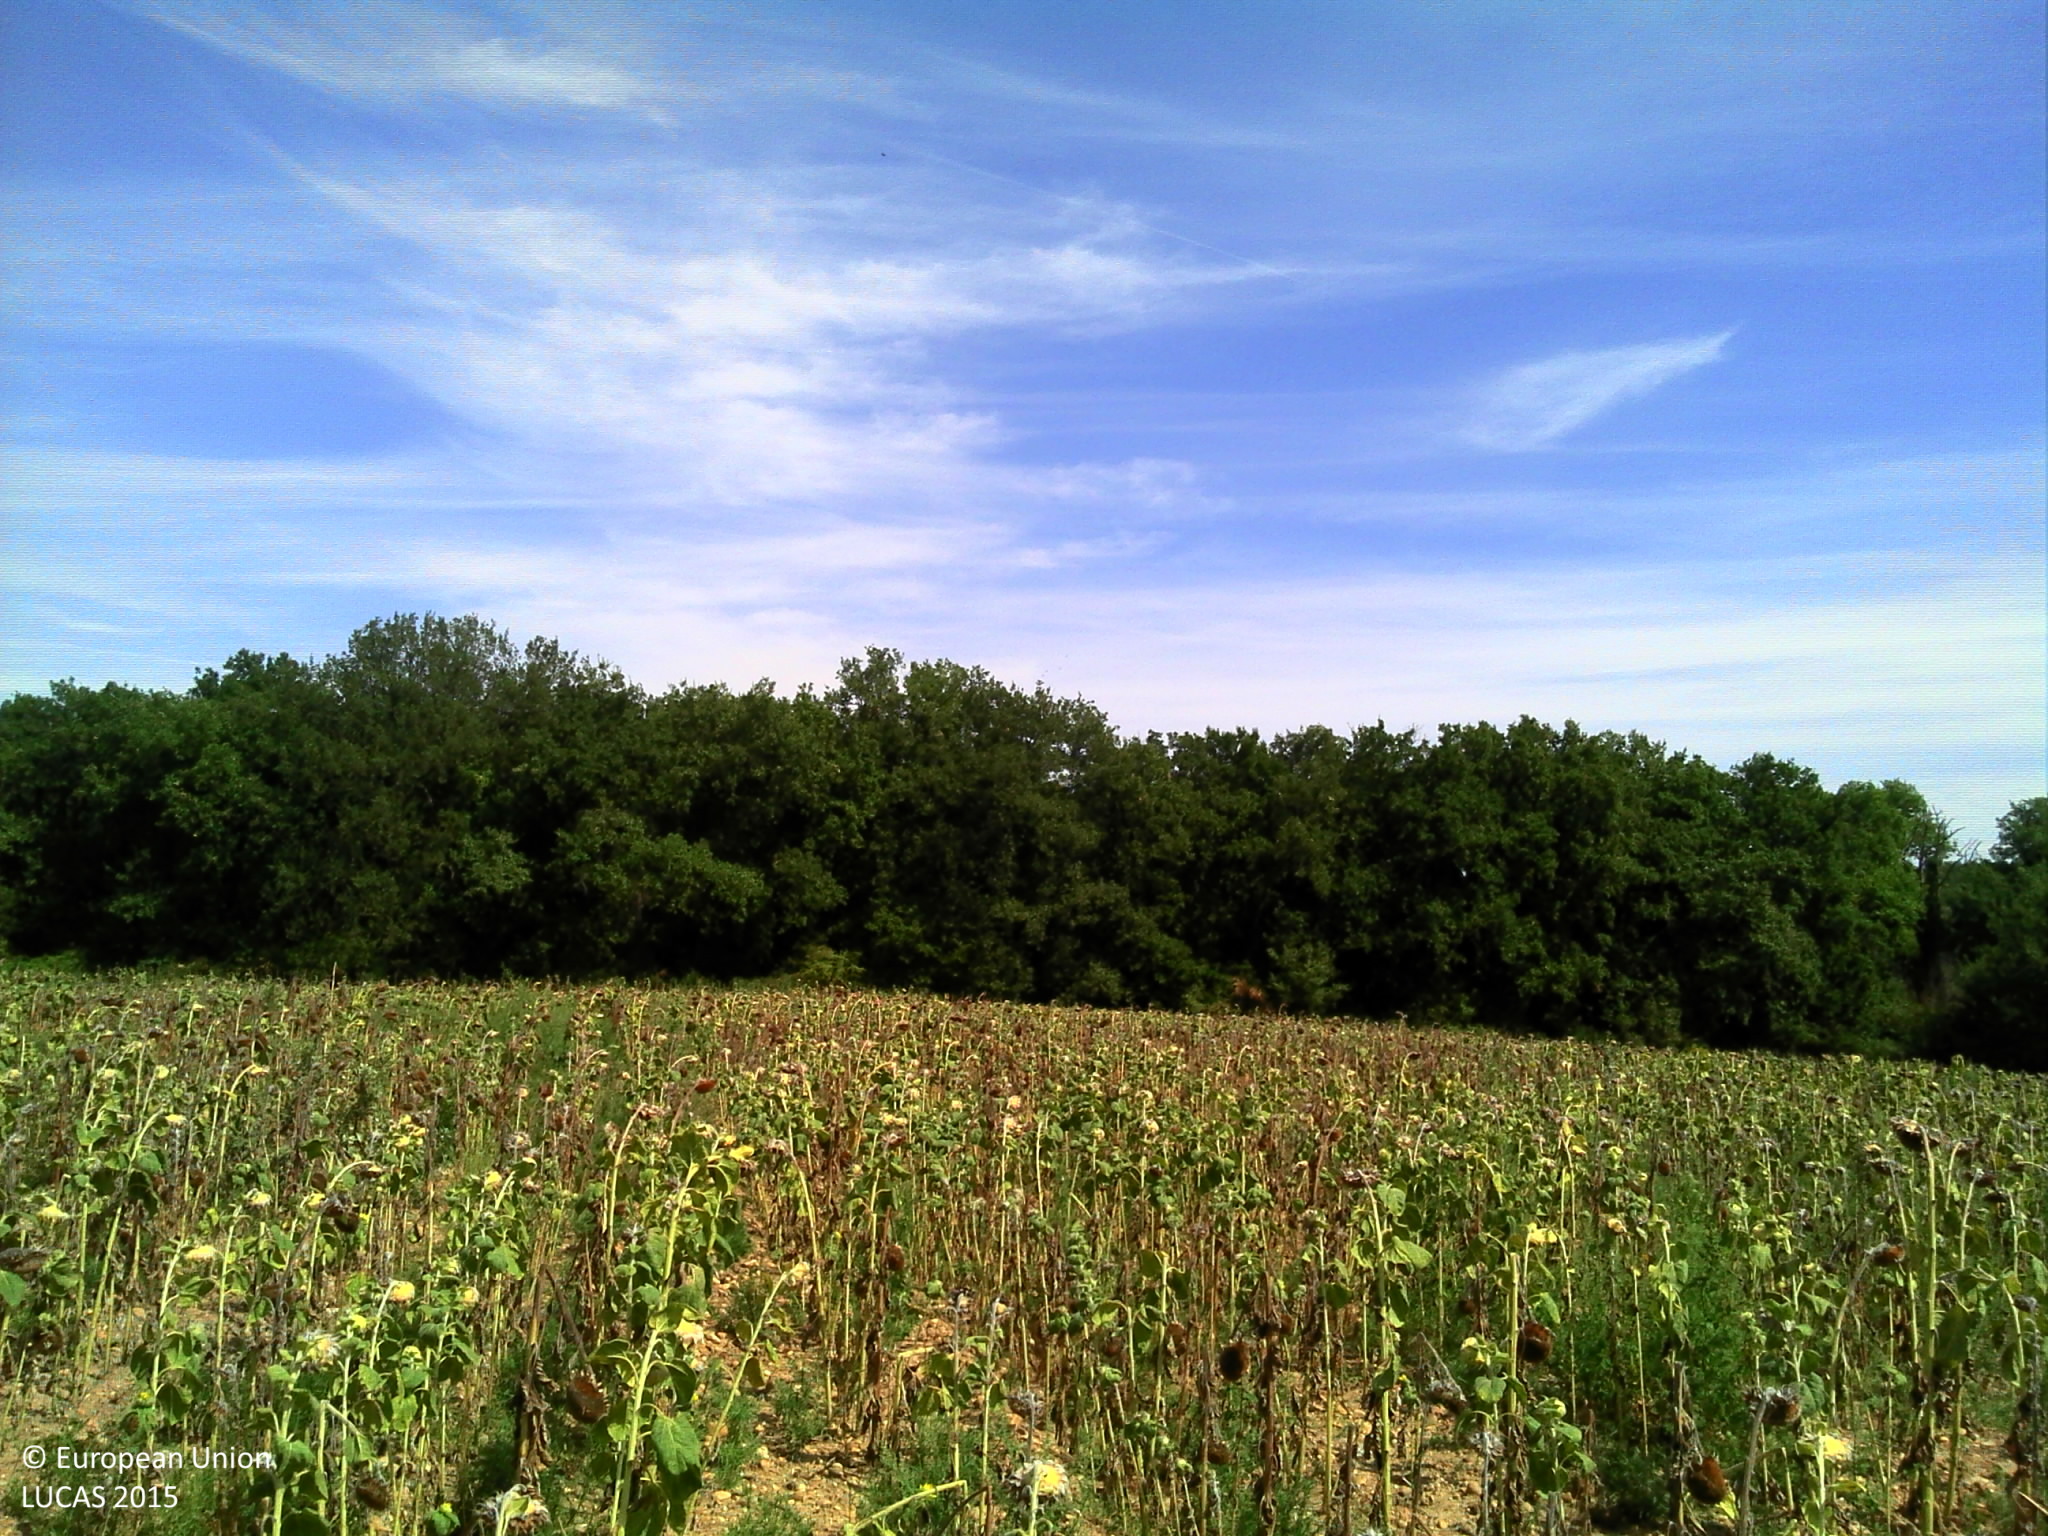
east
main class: Cropland
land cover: Sunflower
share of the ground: 50 - 75 %
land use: Agriculture (excluding fallow land and kitchen gardens)
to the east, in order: Sunflower; Broadleaved woodland; Other fruit trees and berries
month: September
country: FR
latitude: 44.5254
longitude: 4.7599
